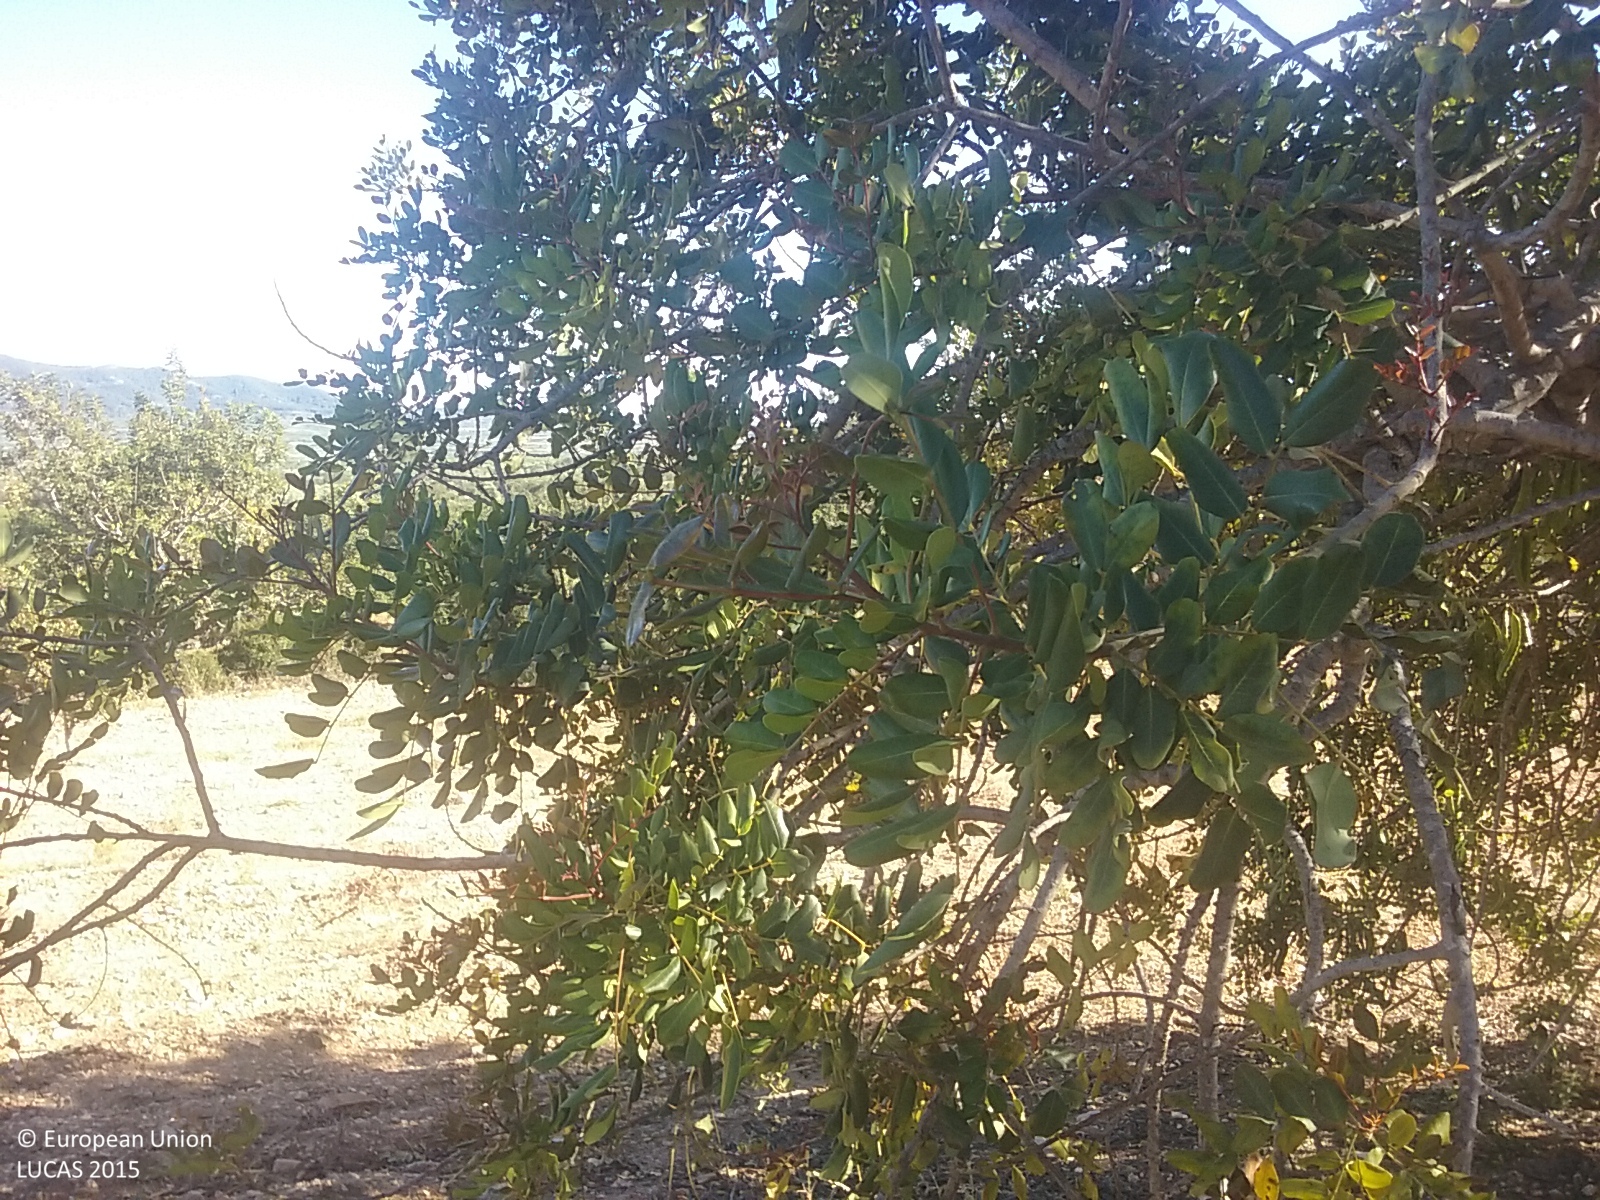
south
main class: Cropland
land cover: Permanent industrial crops
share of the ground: 10 - 25 %
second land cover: Other bare soil
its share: > 75 %
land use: Agriculture (excluding fallow land and kitchen gardens)
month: May
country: ES
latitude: 40.3439
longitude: 0.2374
